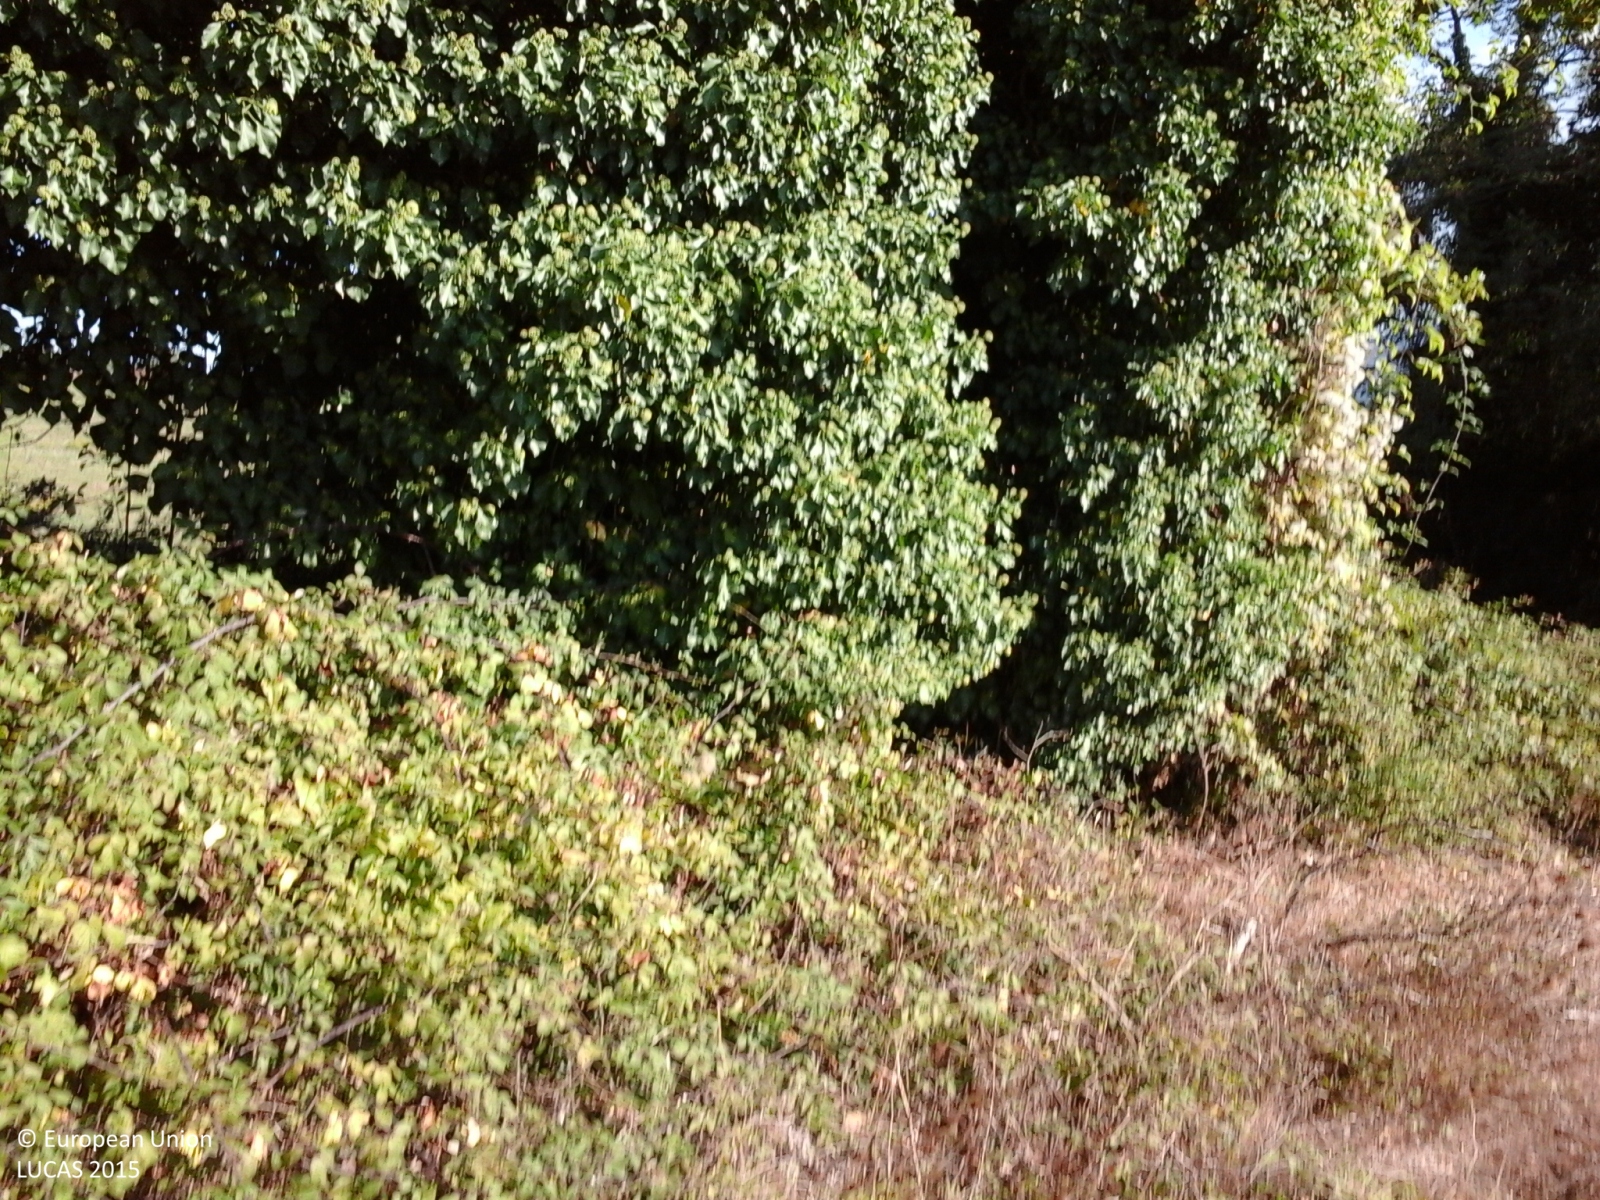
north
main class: Cropland
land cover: Durum wheat
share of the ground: < 10 %
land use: Agriculture (excluding fallow land and kitchen gardens)
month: September
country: IT
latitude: 43.2785
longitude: 12.9864
